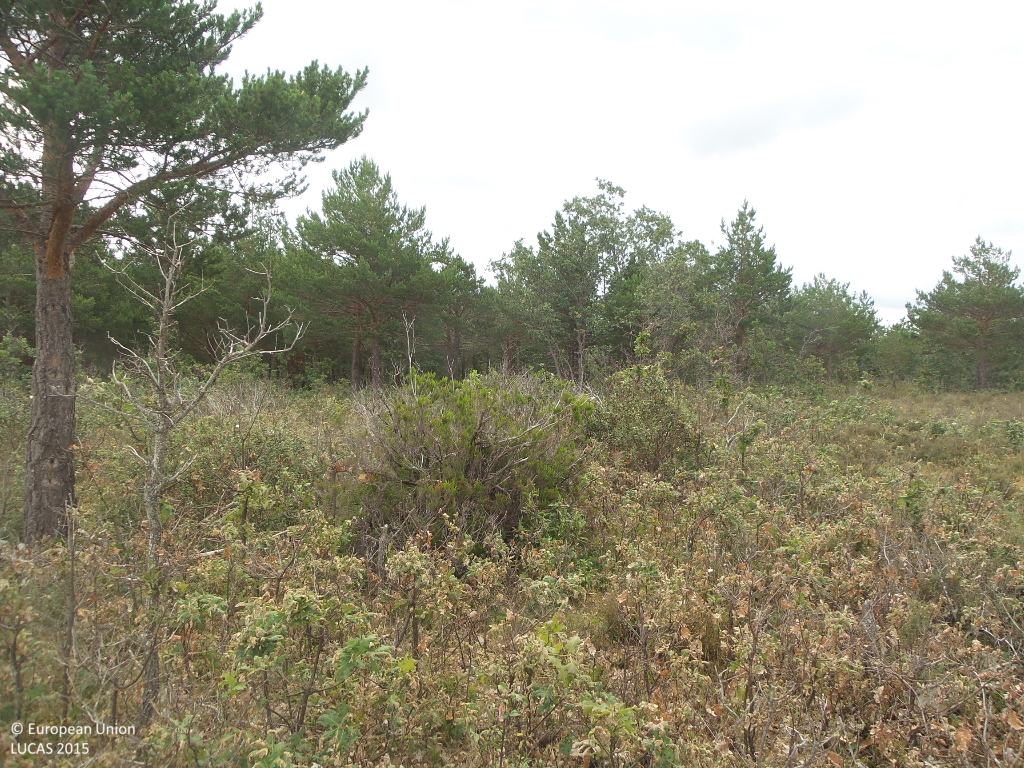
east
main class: Shrubland
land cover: Shrubland with sparse tree cover
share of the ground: > 75 %
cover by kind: shrubs 80 %, coniferous forest trees 5 %, herbaceous plants 5 %, lichens and mosses 5 %, unconsolidated bare surface 5 %
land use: Forestry
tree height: < 5 m
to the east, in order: Shrubland with sparse tree cover; Pine dominated mixed woodland; Broadleaved woodland; Rivers and streams; Broadleaved woodland; Other mixed woodland
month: June
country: ES
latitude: 41.3153
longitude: -3.4361
